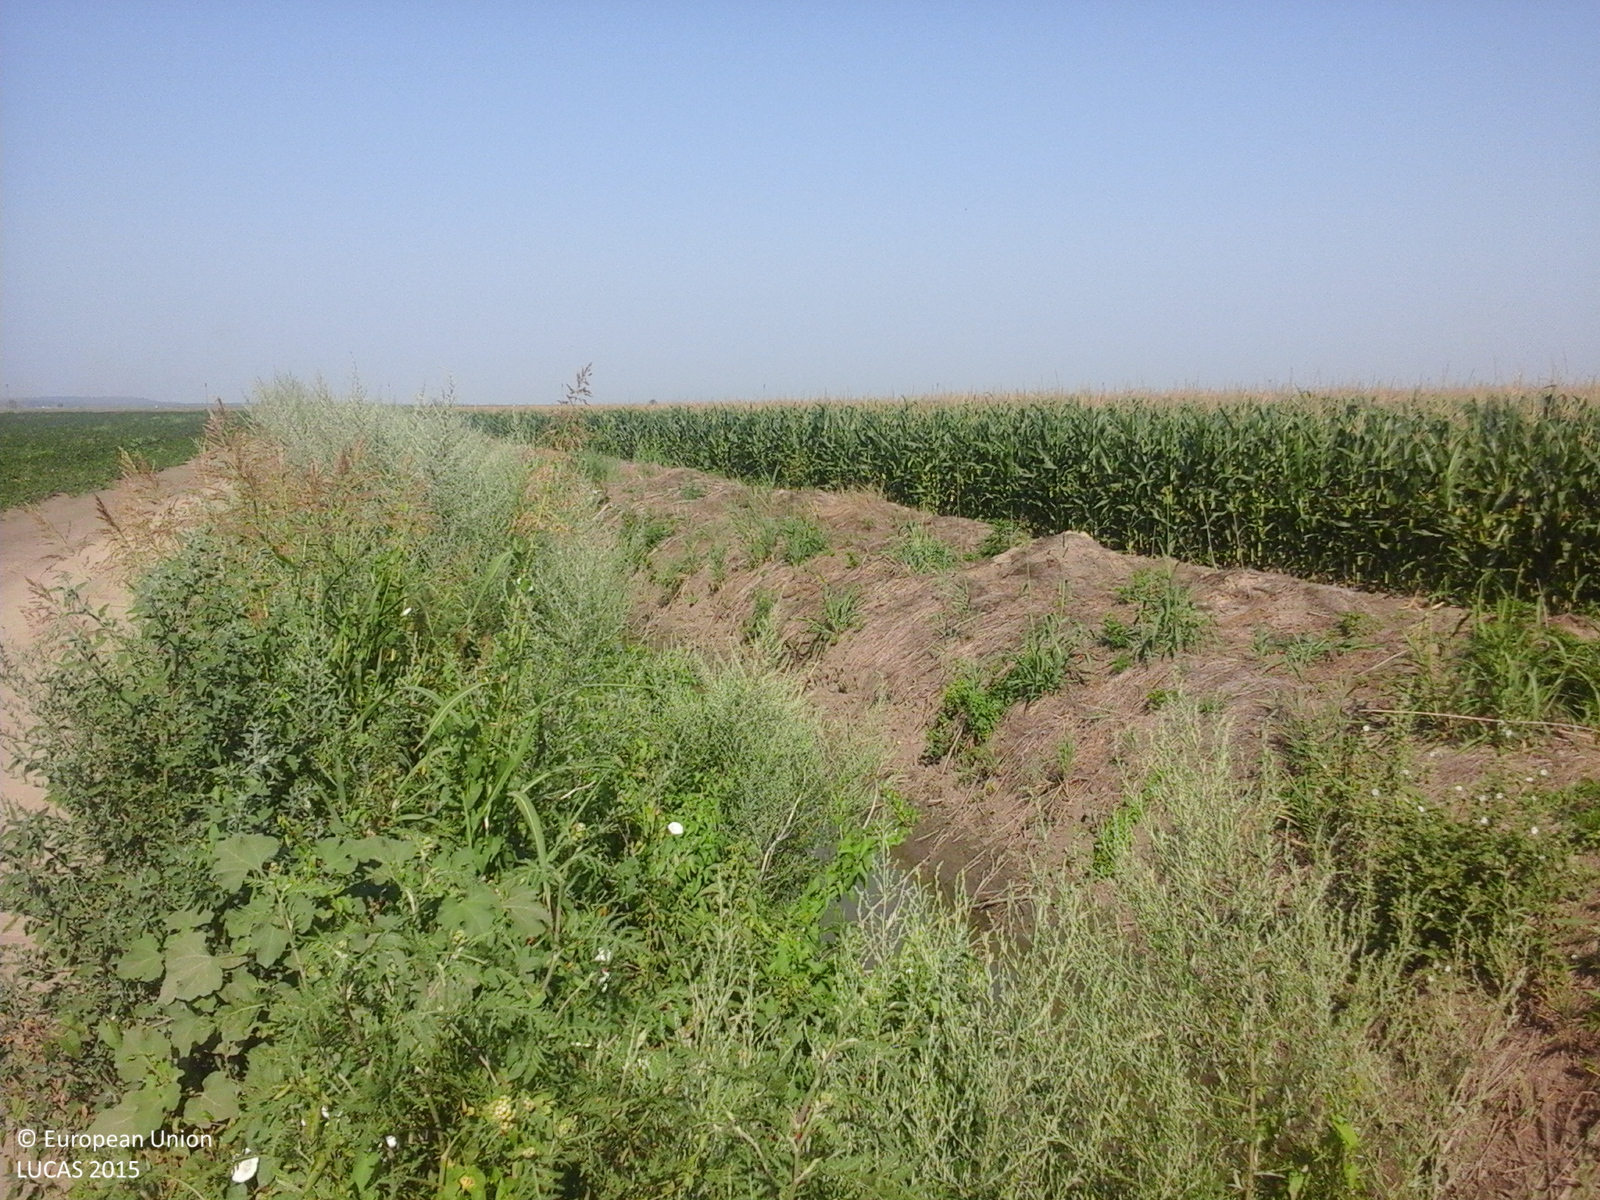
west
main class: Cropland
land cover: Maize
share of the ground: > 75 %
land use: Agriculture (excluding fallow land and kitchen gardens)
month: July
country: RO
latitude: 44.1668
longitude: 27.2271
